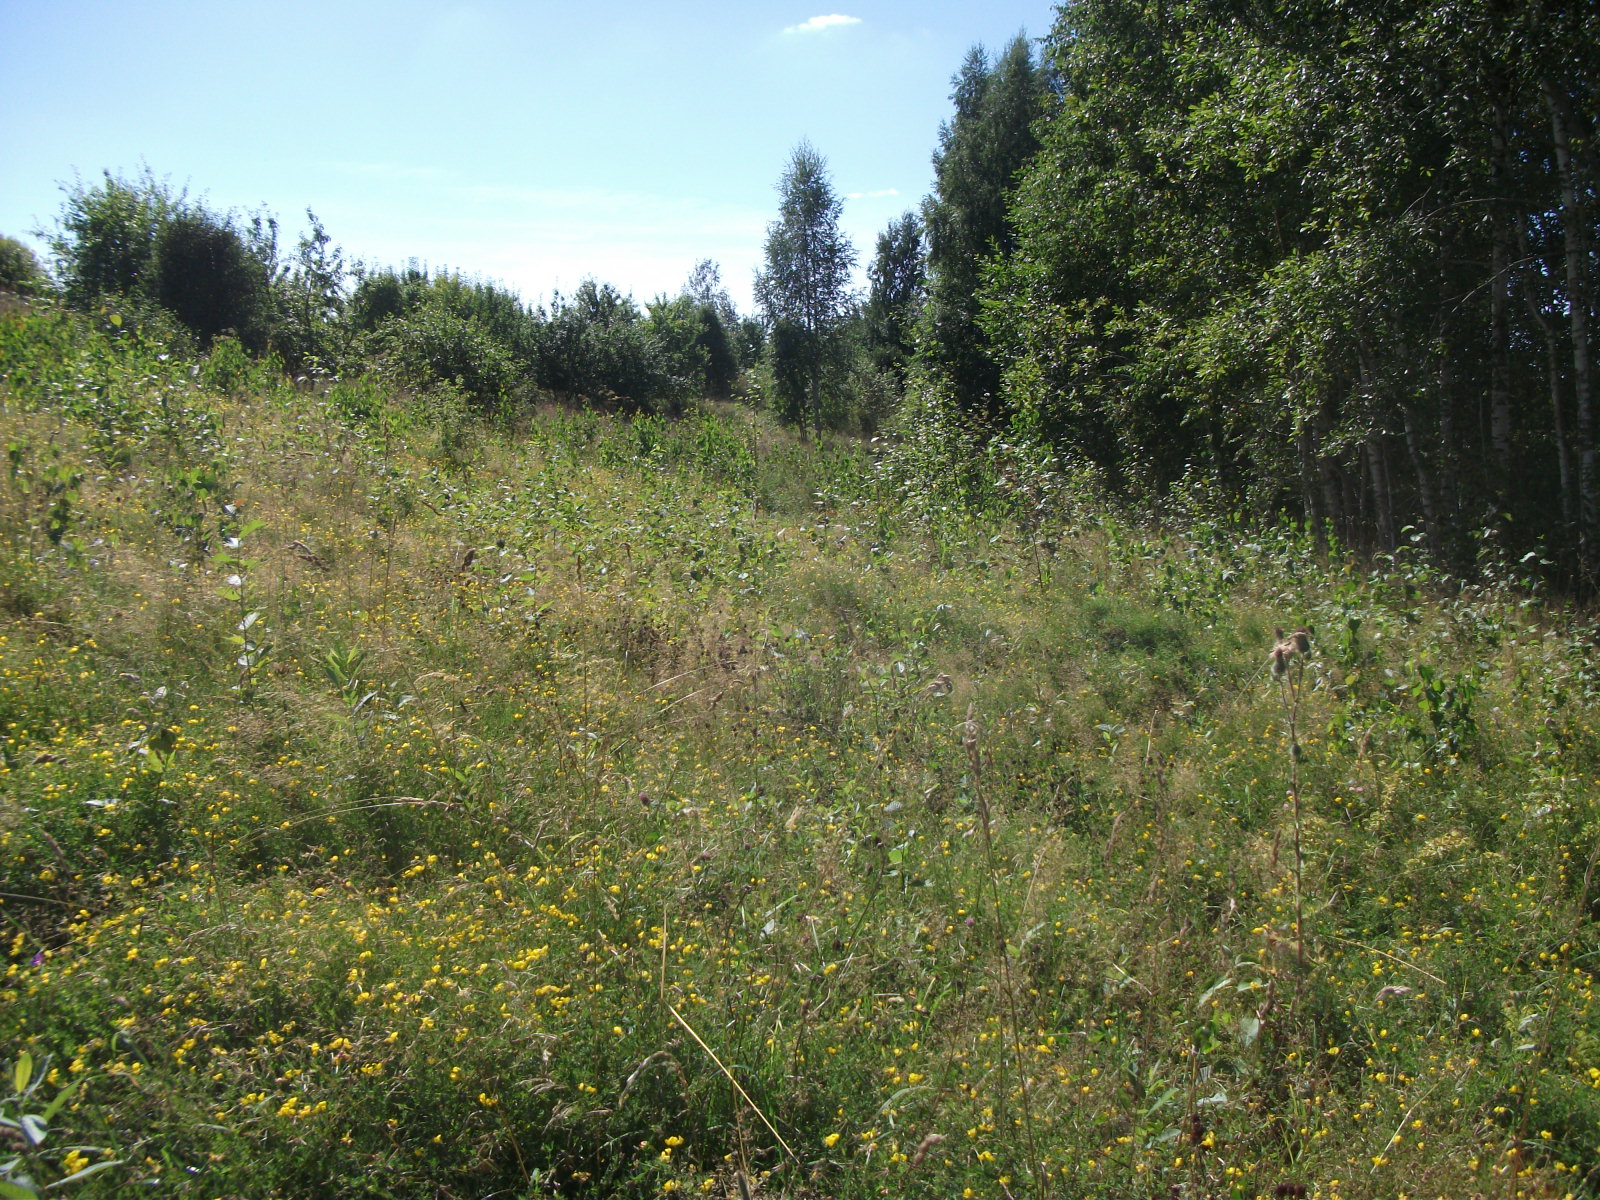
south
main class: Grassland
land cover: Spontaneously vegetated surfaces
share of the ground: > 75 %
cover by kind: herbaceous plants 85 %, unconsolidated bare surface 10 %, shrubs 5 %
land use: Abandoned areas
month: August
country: LV
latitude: 56.4753
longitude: 26.0283
